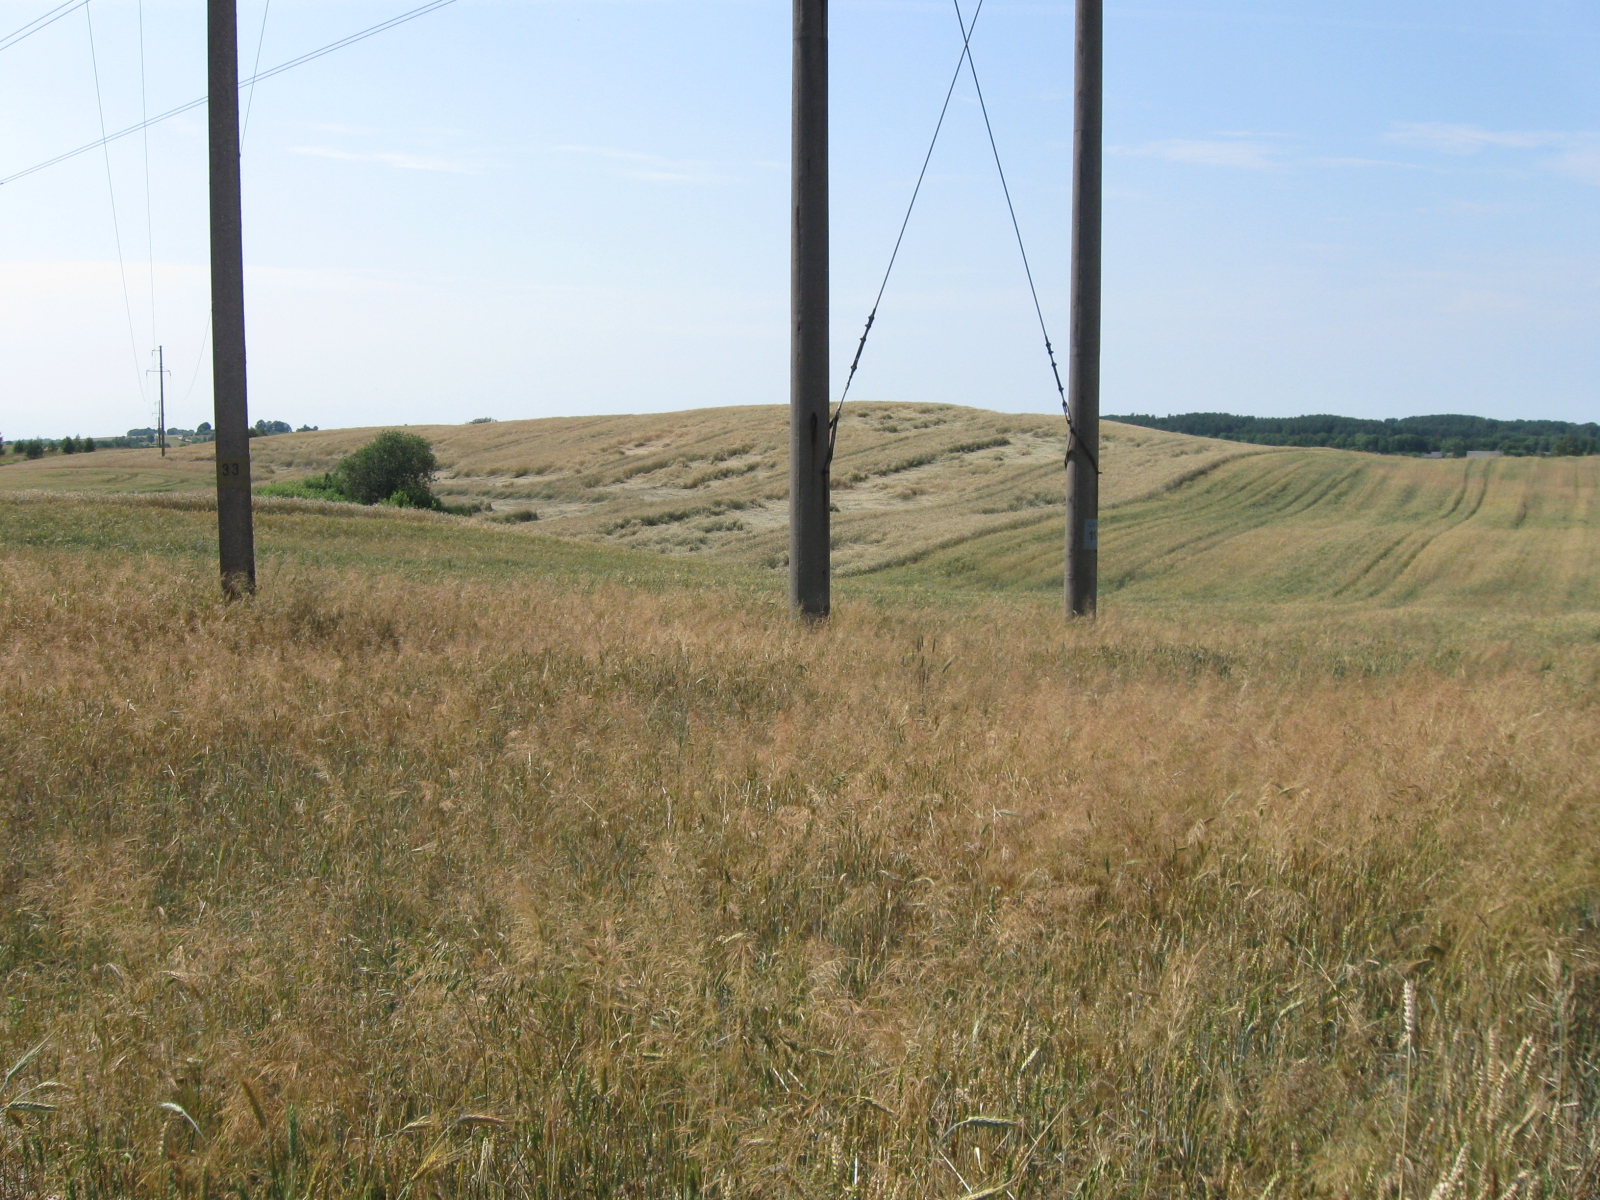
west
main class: Cropland
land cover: Common wheat
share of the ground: > 75 %
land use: Agriculture (excluding fallow land and kitchen gardens)
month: July
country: LT
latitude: 54.6761
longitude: 23.9075
